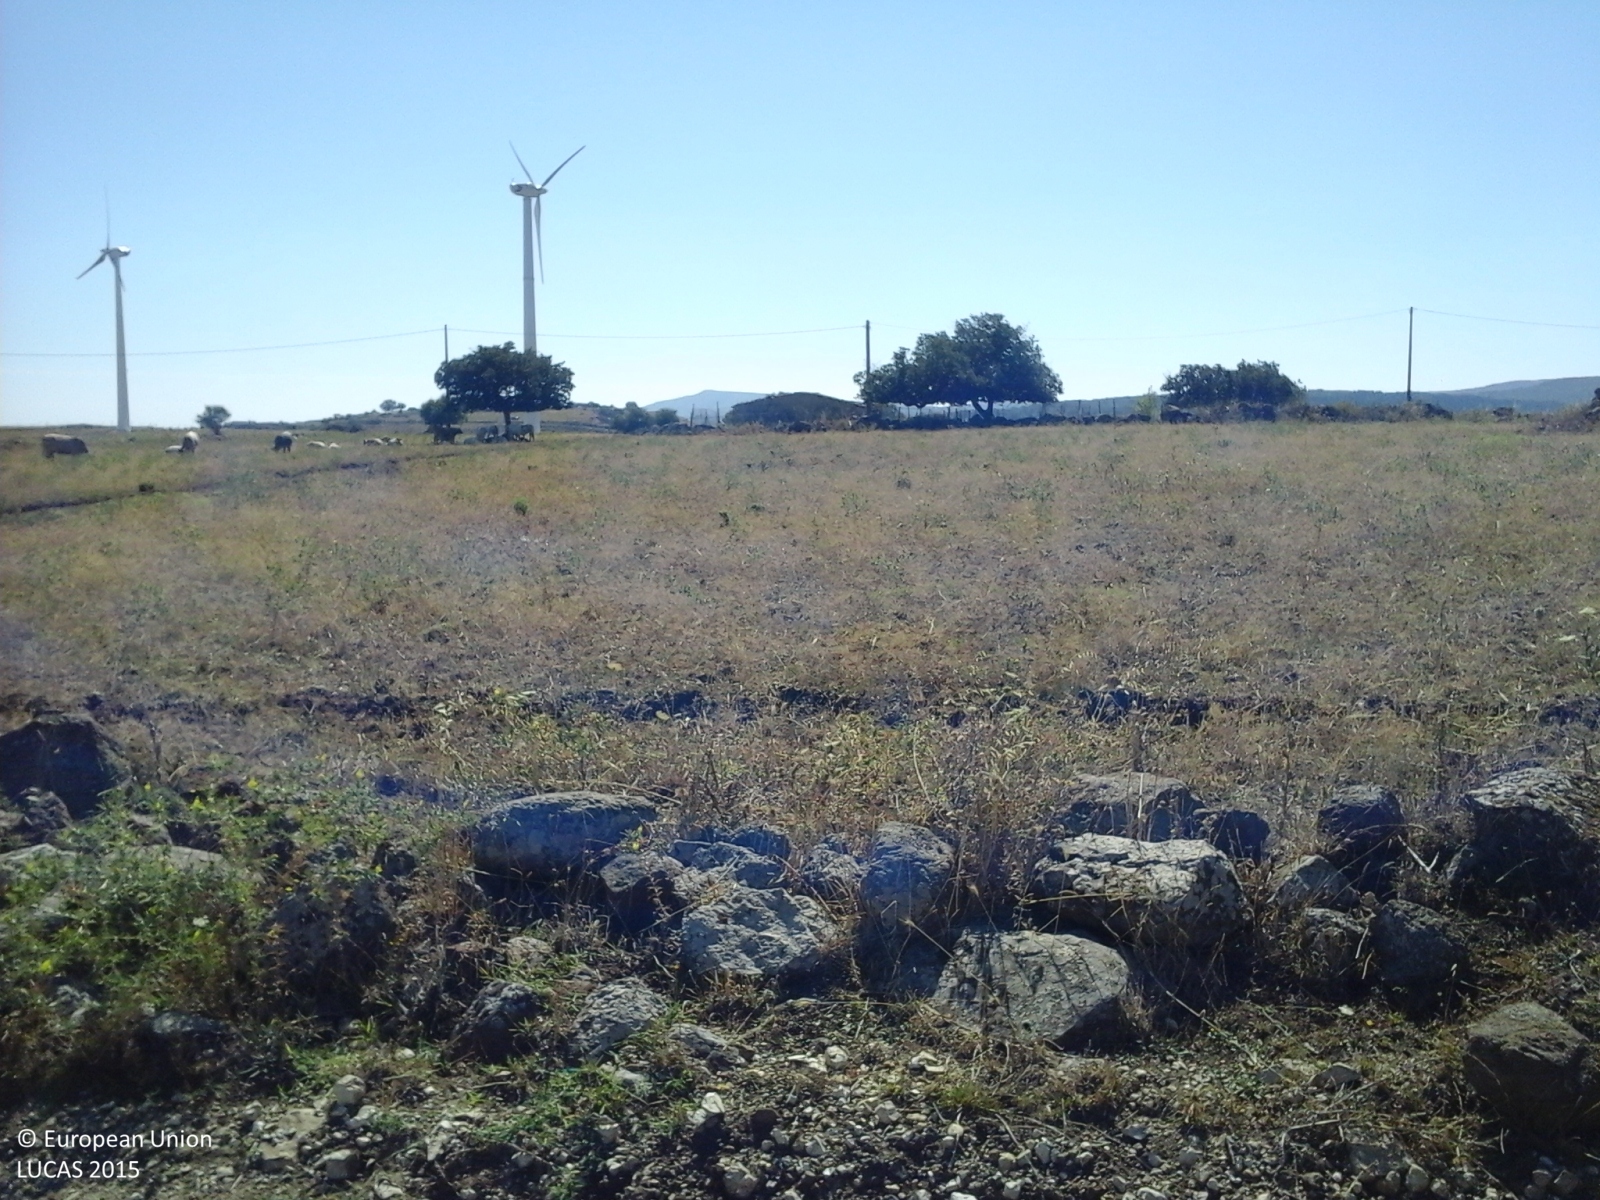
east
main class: Cropland
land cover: Mixed cereals for fodder
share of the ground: > 75 %
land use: Agriculture (excluding fallow land and kitchen gardens)
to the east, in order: Mixed cereals for fodder; Fences; Rocks and stones; Tracks; Mixed cereals for fodder; Tracks; Mixed cereals for fodder; Single bushes/trees; Mixed cereals for fodder
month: July
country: IT
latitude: 37.1708
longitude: 14.8173
